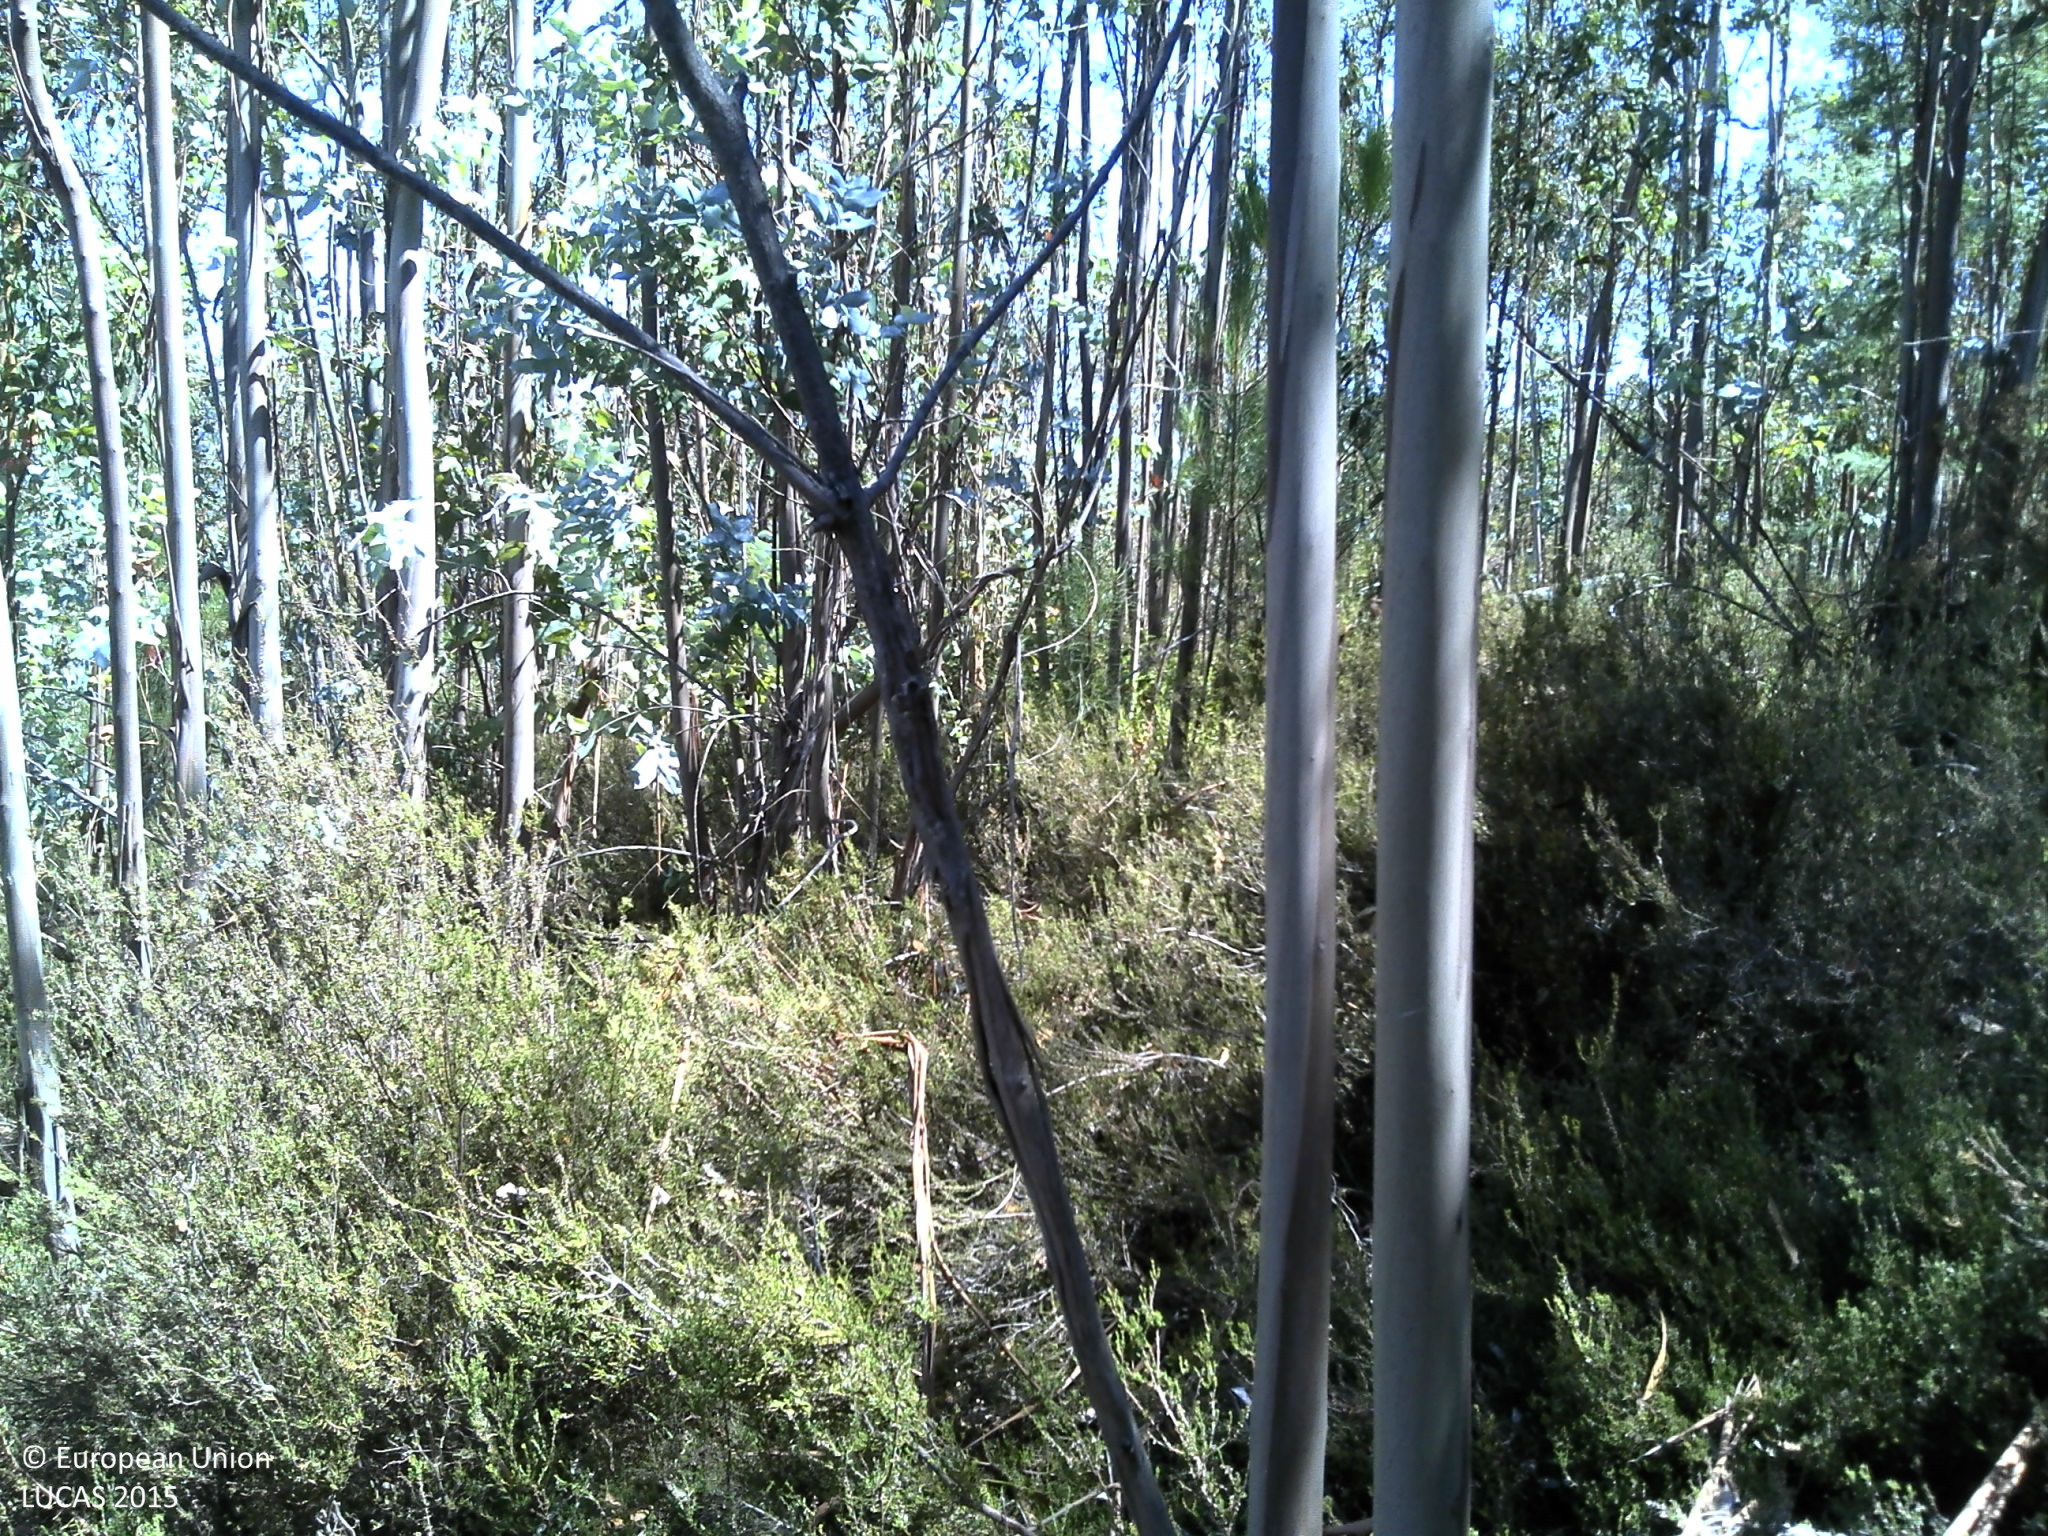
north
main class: Woodland
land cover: Broadleaved woodland
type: exotic forest
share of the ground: 10 - 25 %
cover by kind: shrubs 80 %, broadleaved forest trees 15 %, unconsolidated bare surface 5 %
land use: Forestry
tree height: > 5 m
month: July
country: PT
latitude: 40.0099
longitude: -8.1967
